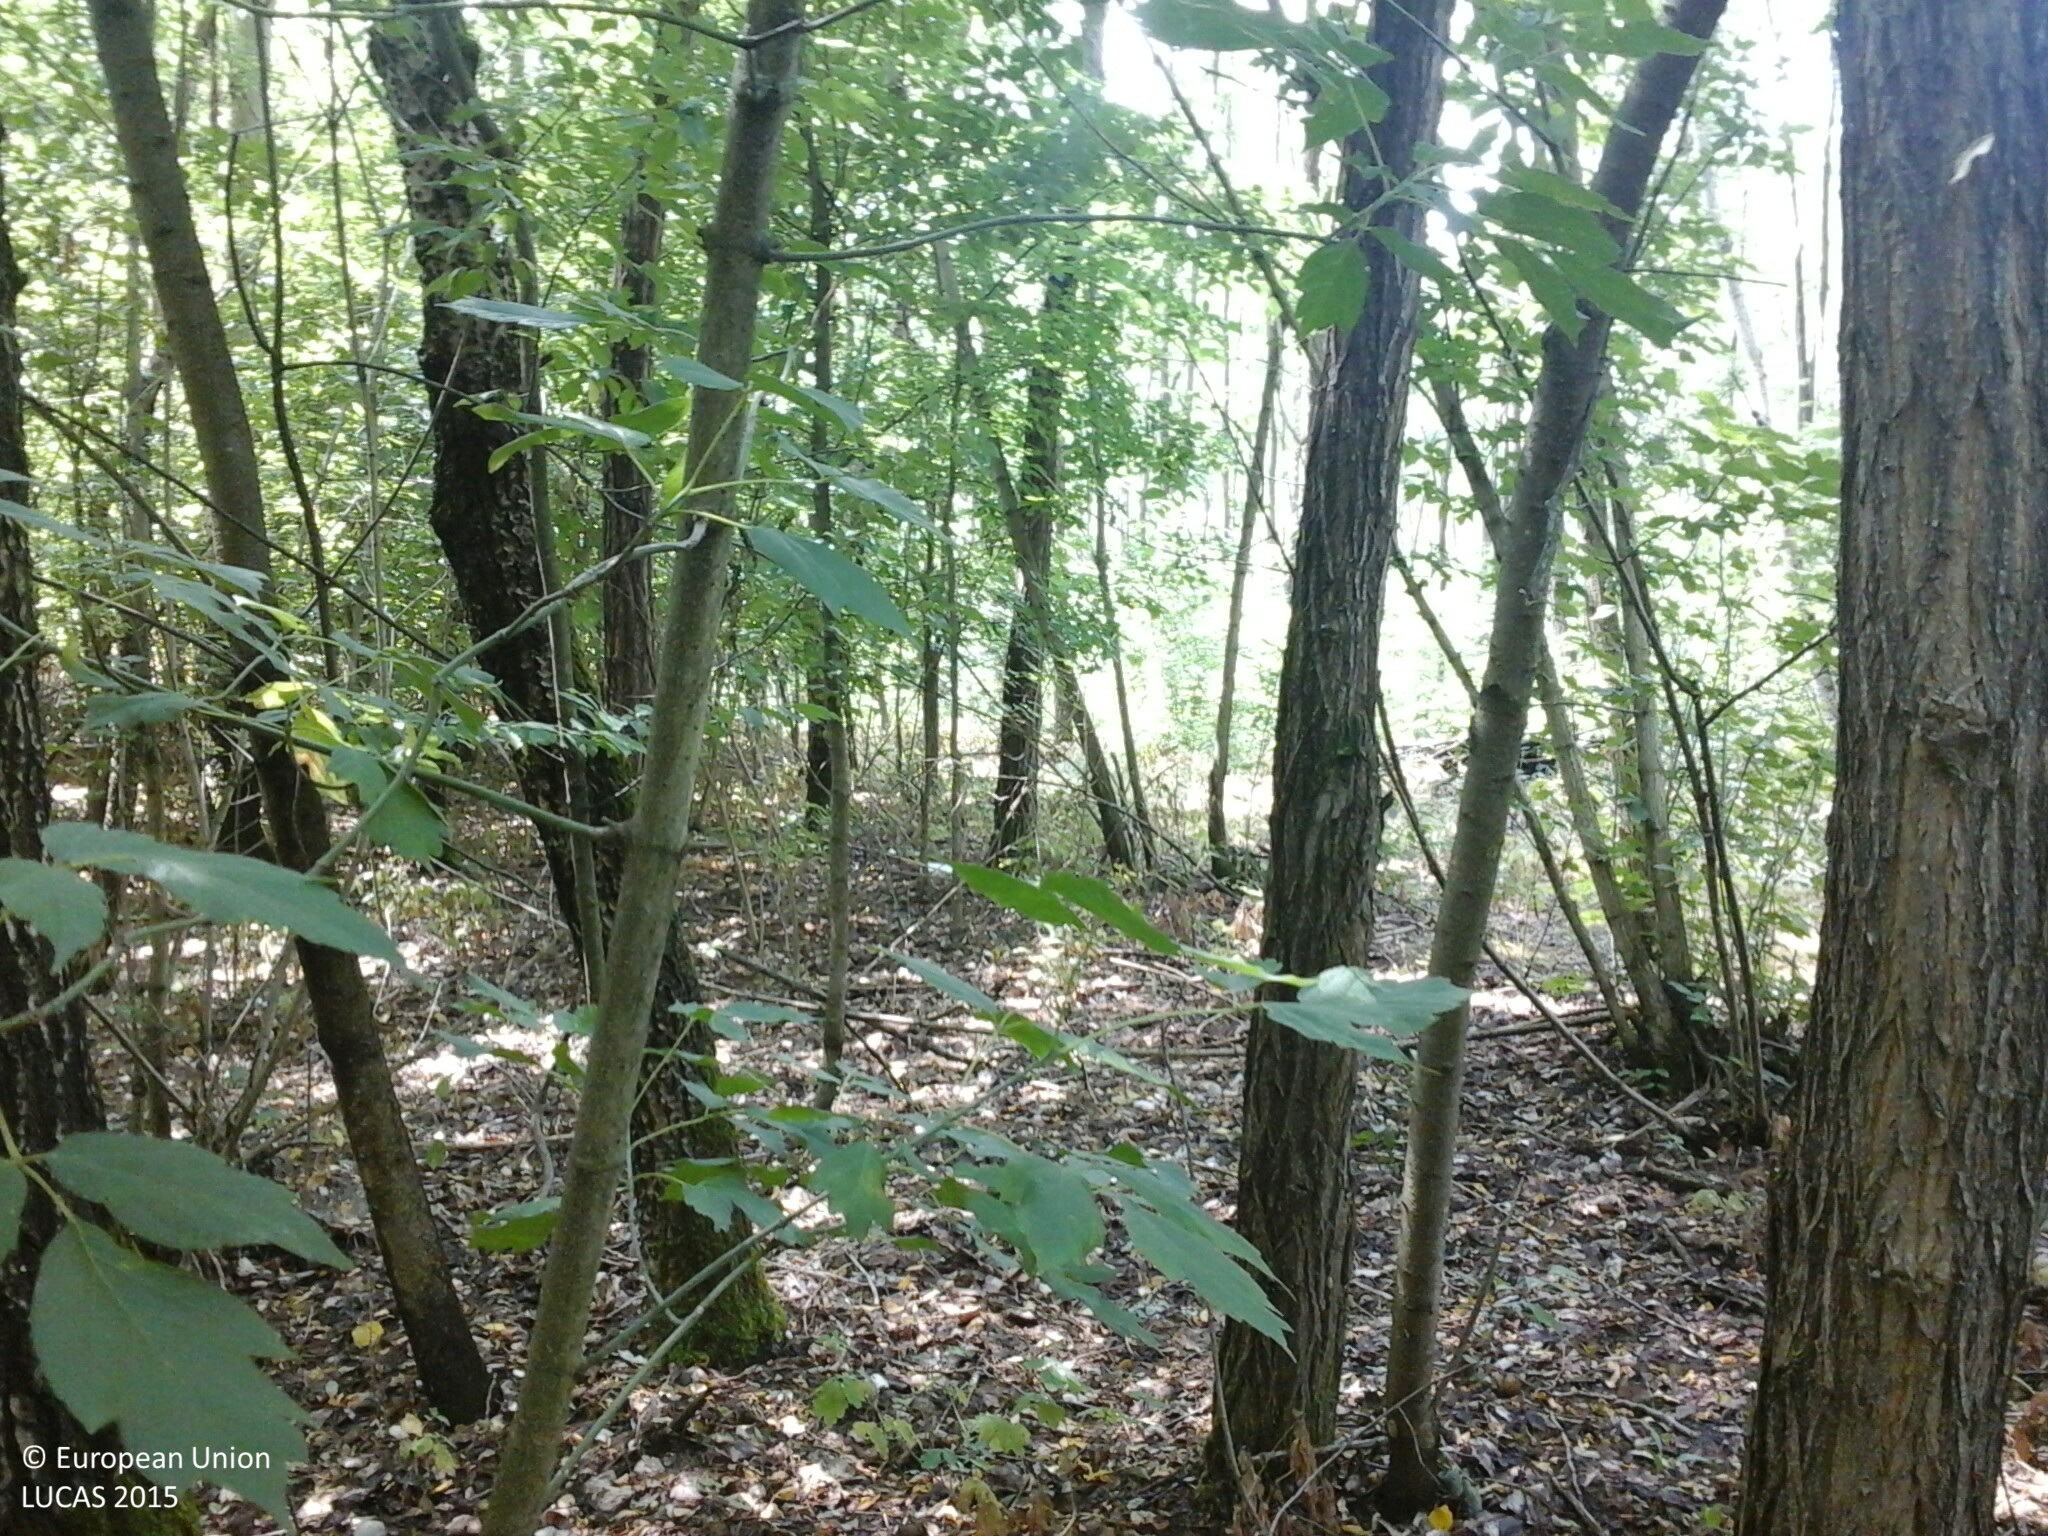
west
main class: Woodland
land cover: Broadleaved woodland
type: mesophytic deciduous forest
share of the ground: > 75 %
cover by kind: broadleaved forest trees 100 %
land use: Forestry
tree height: > 5 m
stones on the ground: < 10 %
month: July
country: HU
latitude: 48.2329
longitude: 22.2135
